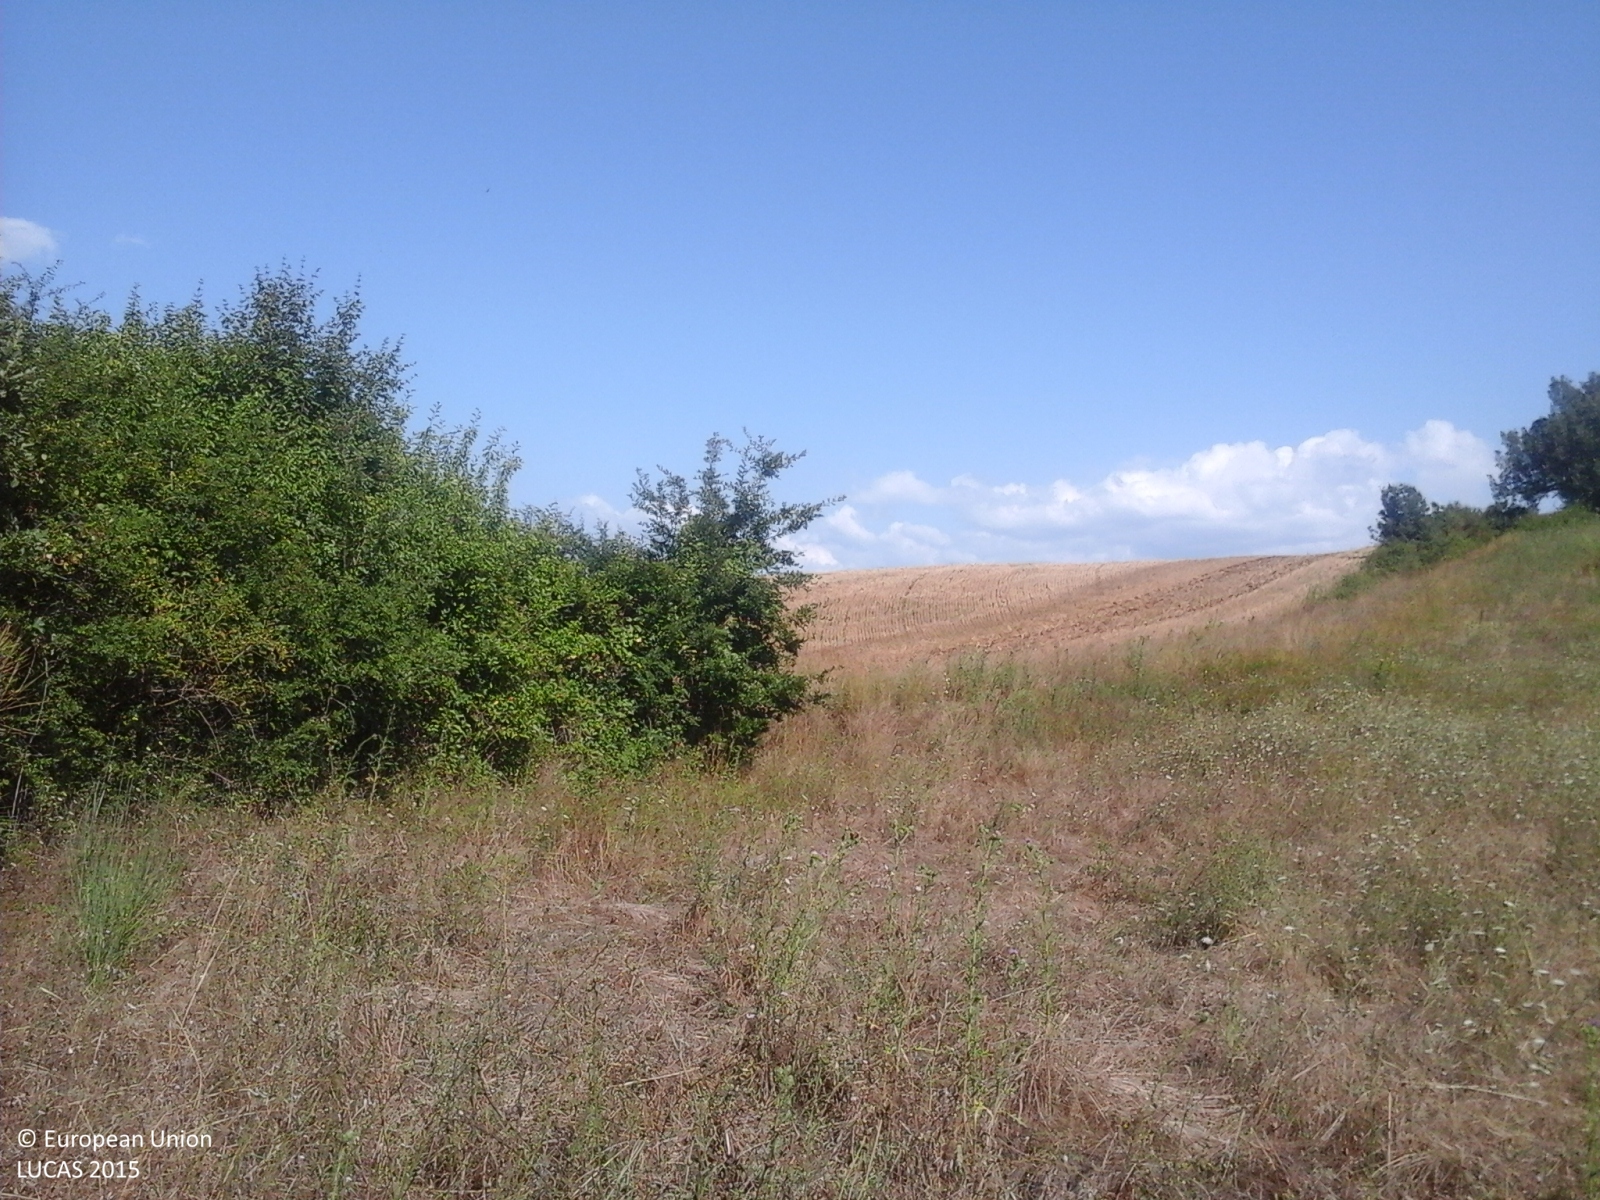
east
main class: Woodland
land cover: Broadleaved woodland
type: thermophilous deciduous forest
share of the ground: > 75 %
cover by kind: broadleaved forest trees 80 %, shrubs 20 %
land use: Forestry
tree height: < 5 m
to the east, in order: Broadleaved woodland; Tracks; Shrubland with sparse tree cover; Tracks; Durum wheat
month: August
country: IT
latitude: 42.6438
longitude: 12.3950
